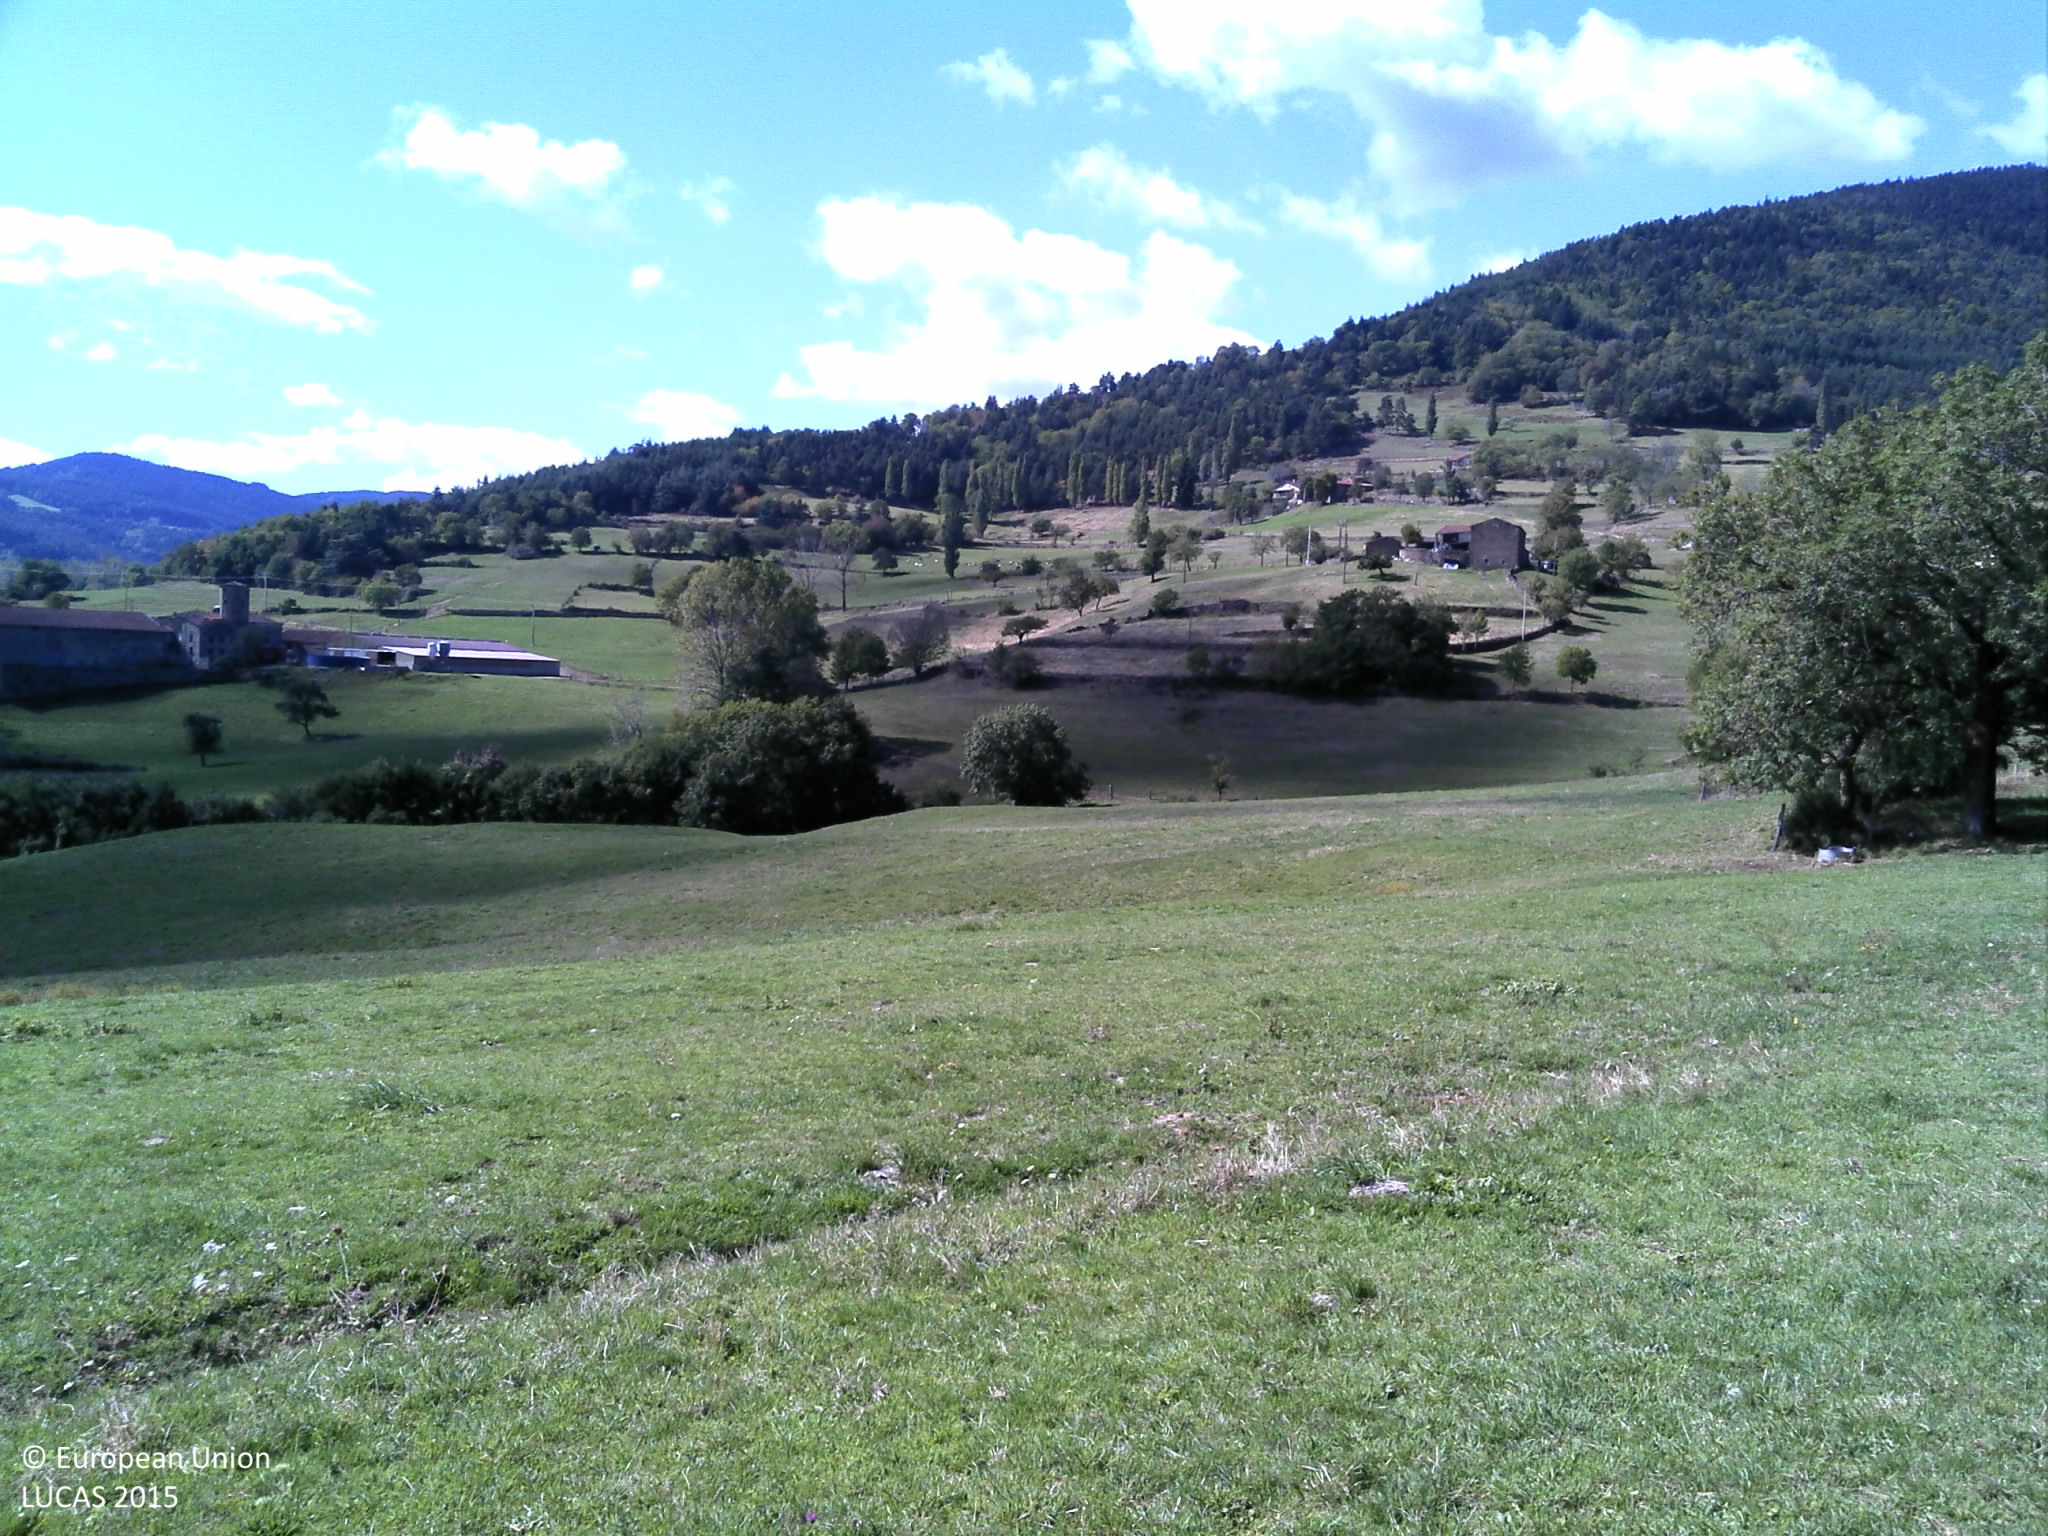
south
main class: Grassland
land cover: Grassland without tree/shrub cover
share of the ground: > 75 %
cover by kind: herbaceous plants 100 %
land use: Agriculture (excluding fallow land and kitchen gardens)
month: September
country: FR
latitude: 45.2380
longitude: 4.5652
